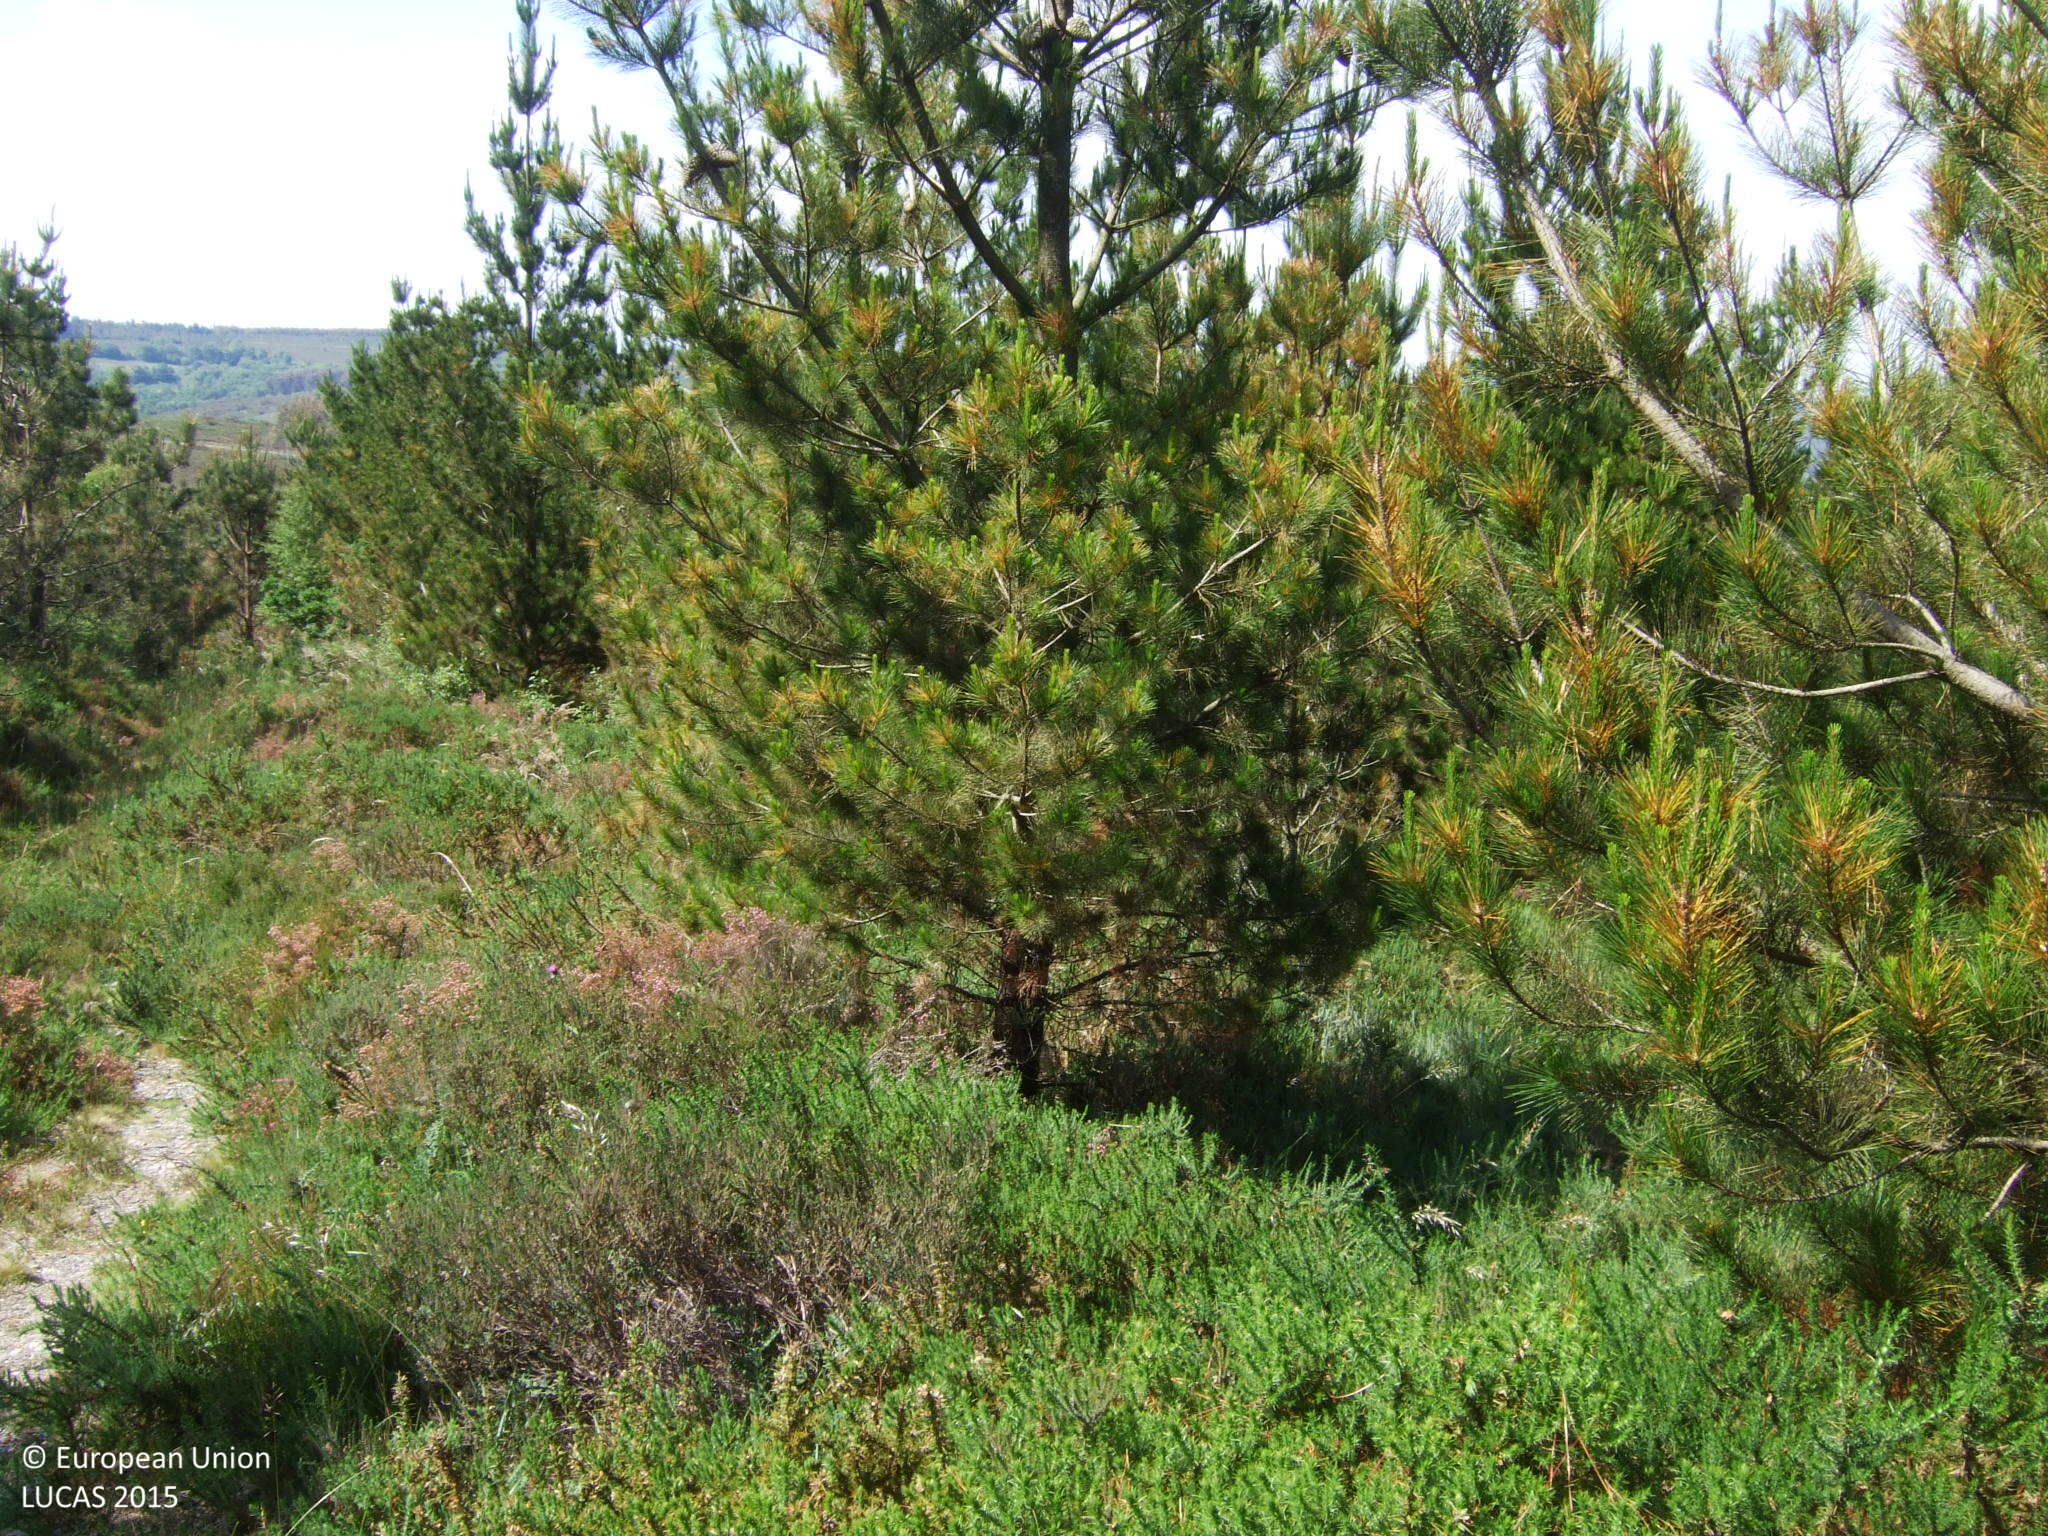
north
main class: Woodland
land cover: Pine dominated coniferous woodland
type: exotic forest
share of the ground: 50 - 75 %
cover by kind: coniferous forest trees 70 %, shrubs 30 %
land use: Forestry
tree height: < 5 m
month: June
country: ES
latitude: 43.4425
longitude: -7.7951
